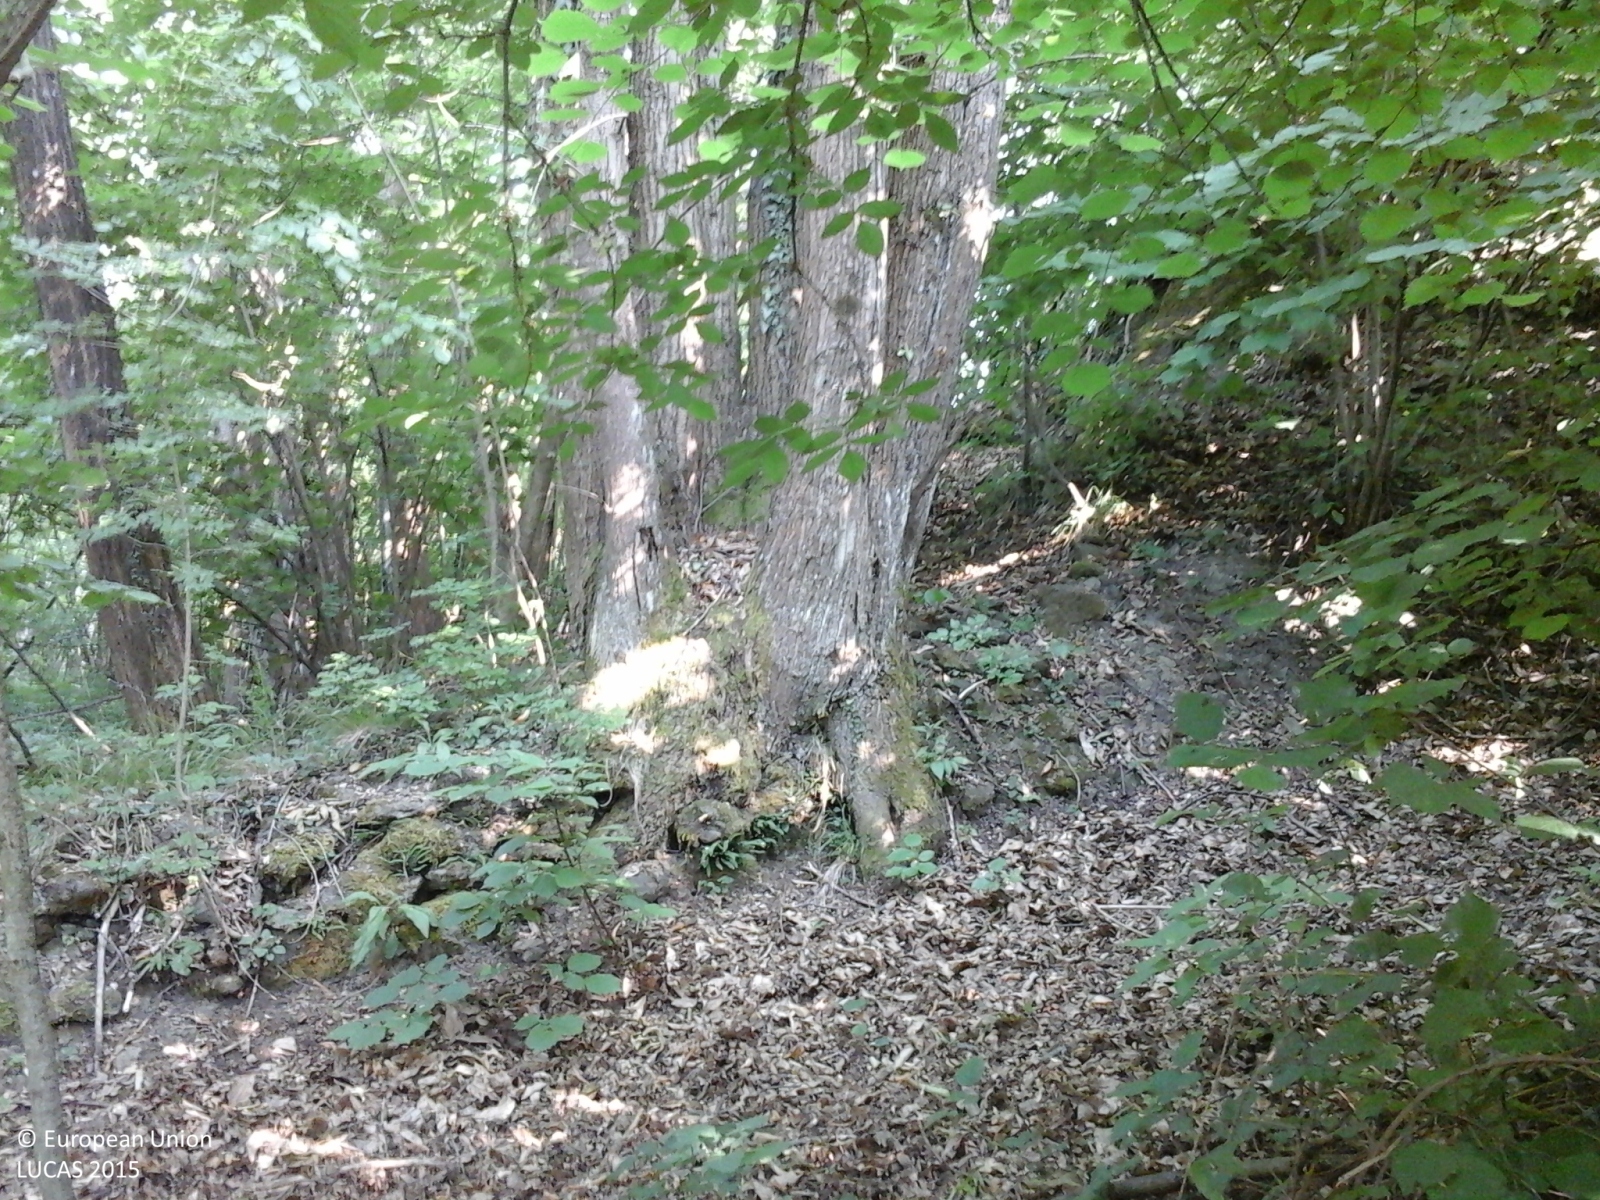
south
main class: Woodland
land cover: Broadleaved woodland
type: thermophilous deciduous forest
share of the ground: > 75 %
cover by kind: broadleaved forest trees 95 %, shrubs 5 %
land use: Forestry
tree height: > 5 m
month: June
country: IT
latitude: 44.5919
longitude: 8.4790
